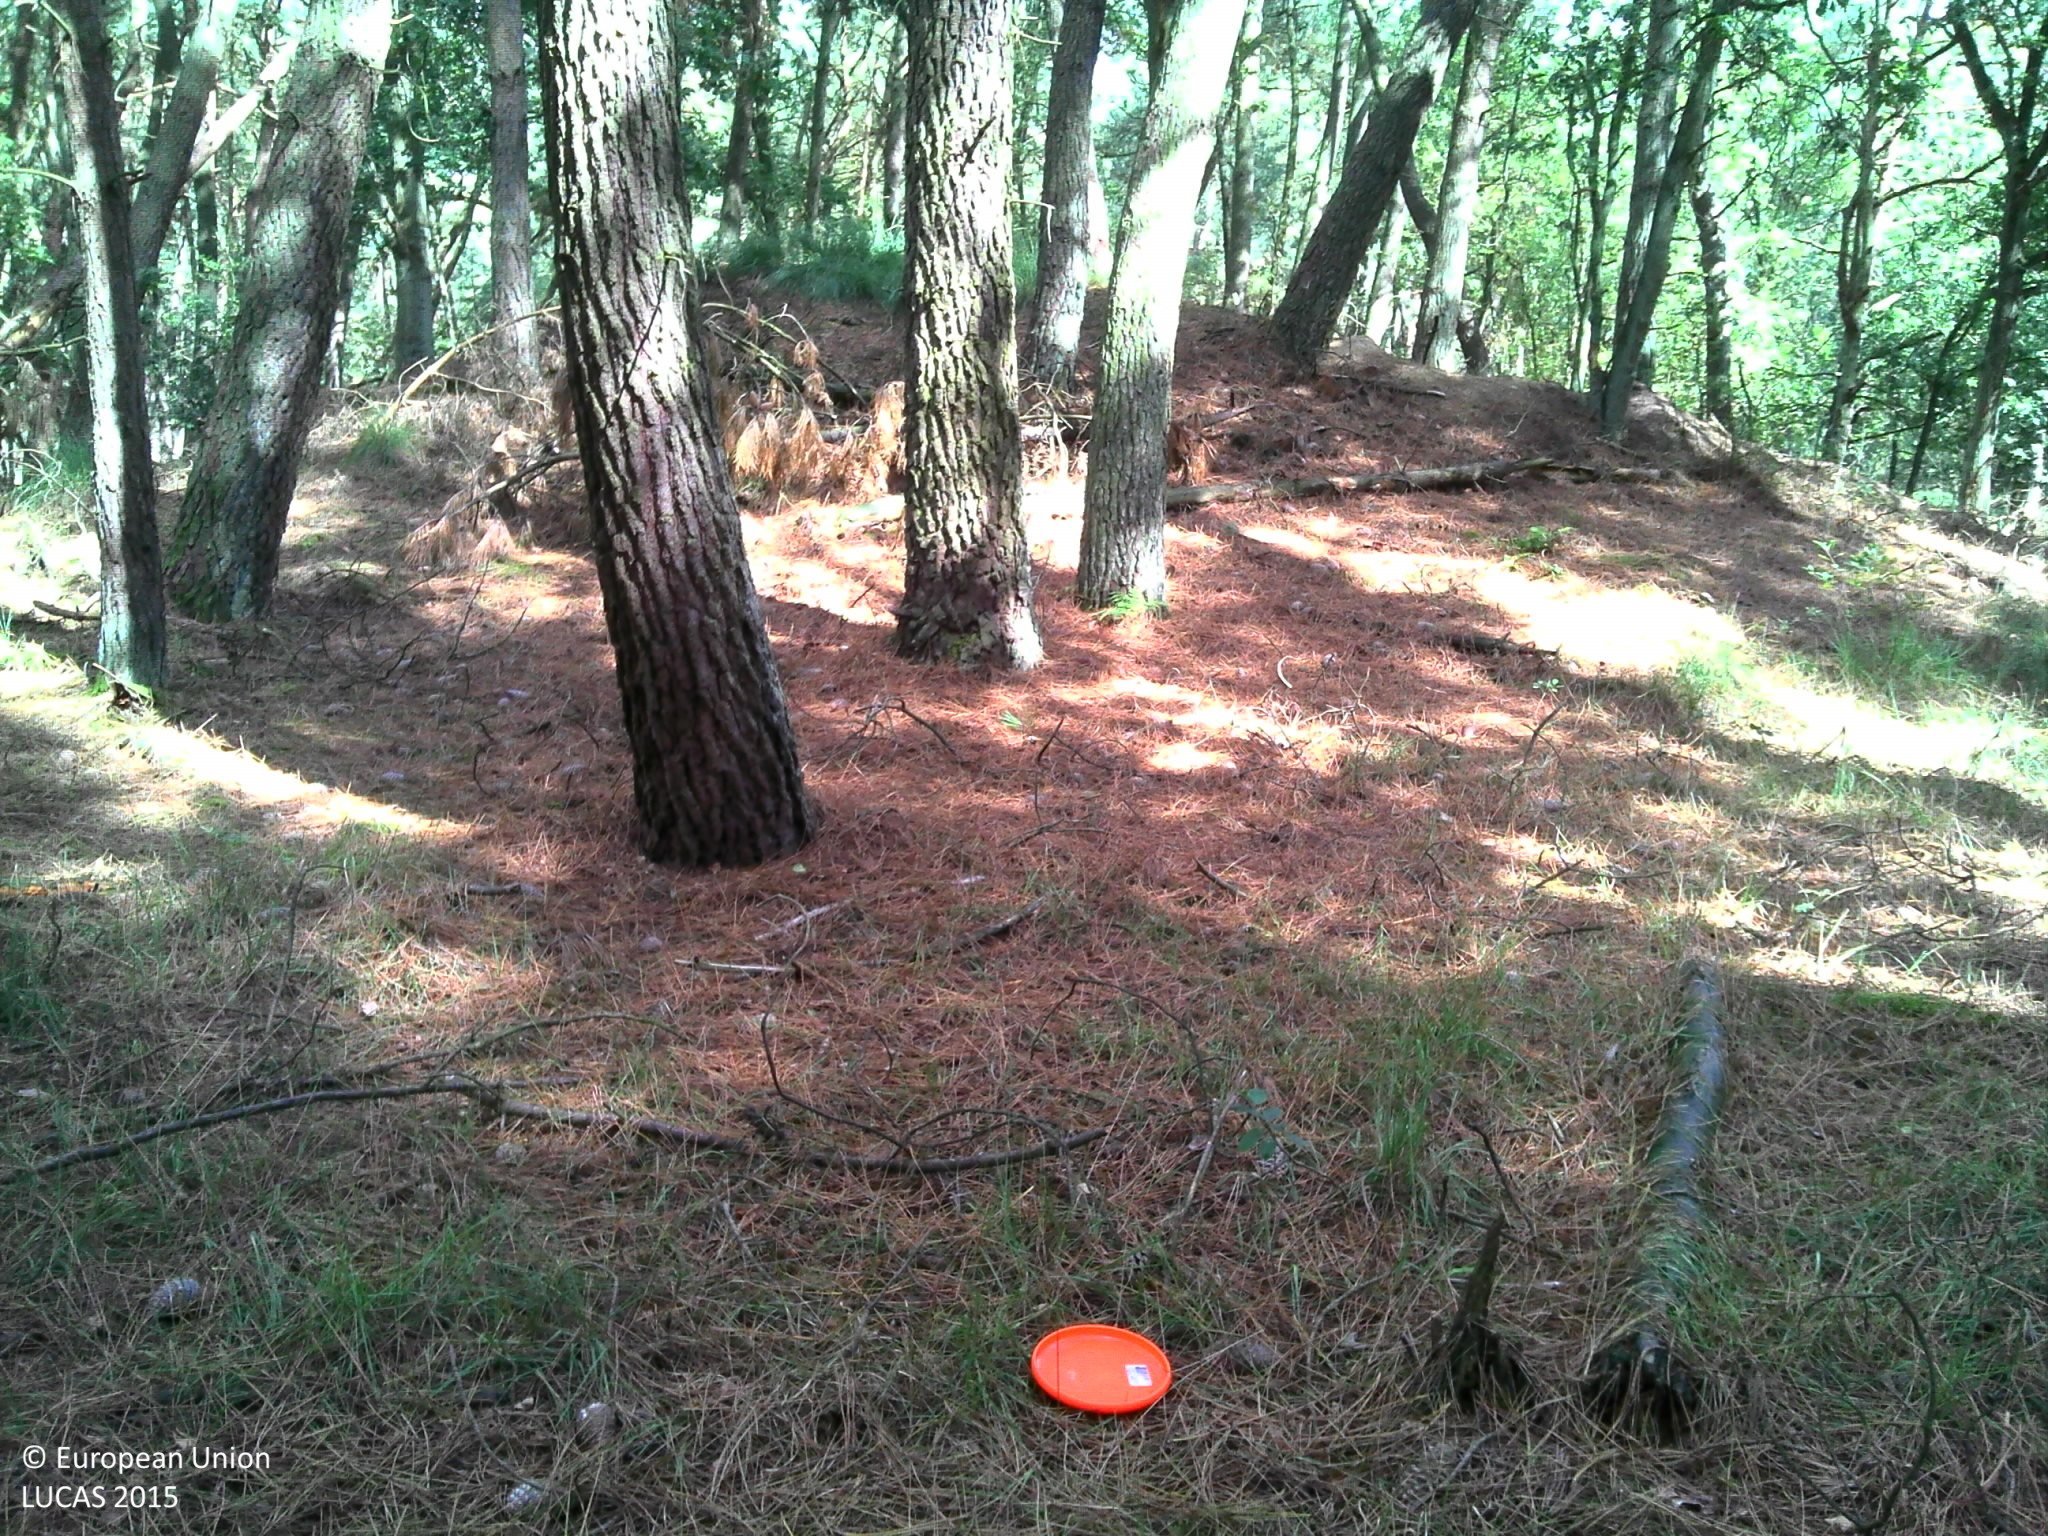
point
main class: Woodland
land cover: Pine dominated coniferous woodland
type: exotic forest
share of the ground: > 75 %
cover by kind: coniferous forest trees 90 %, broadleaved forest trees 5 %, herbaceous plants 5 %
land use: Forestry
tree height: > 5 m
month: September
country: BE
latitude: 51.4165
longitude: 4.4020
